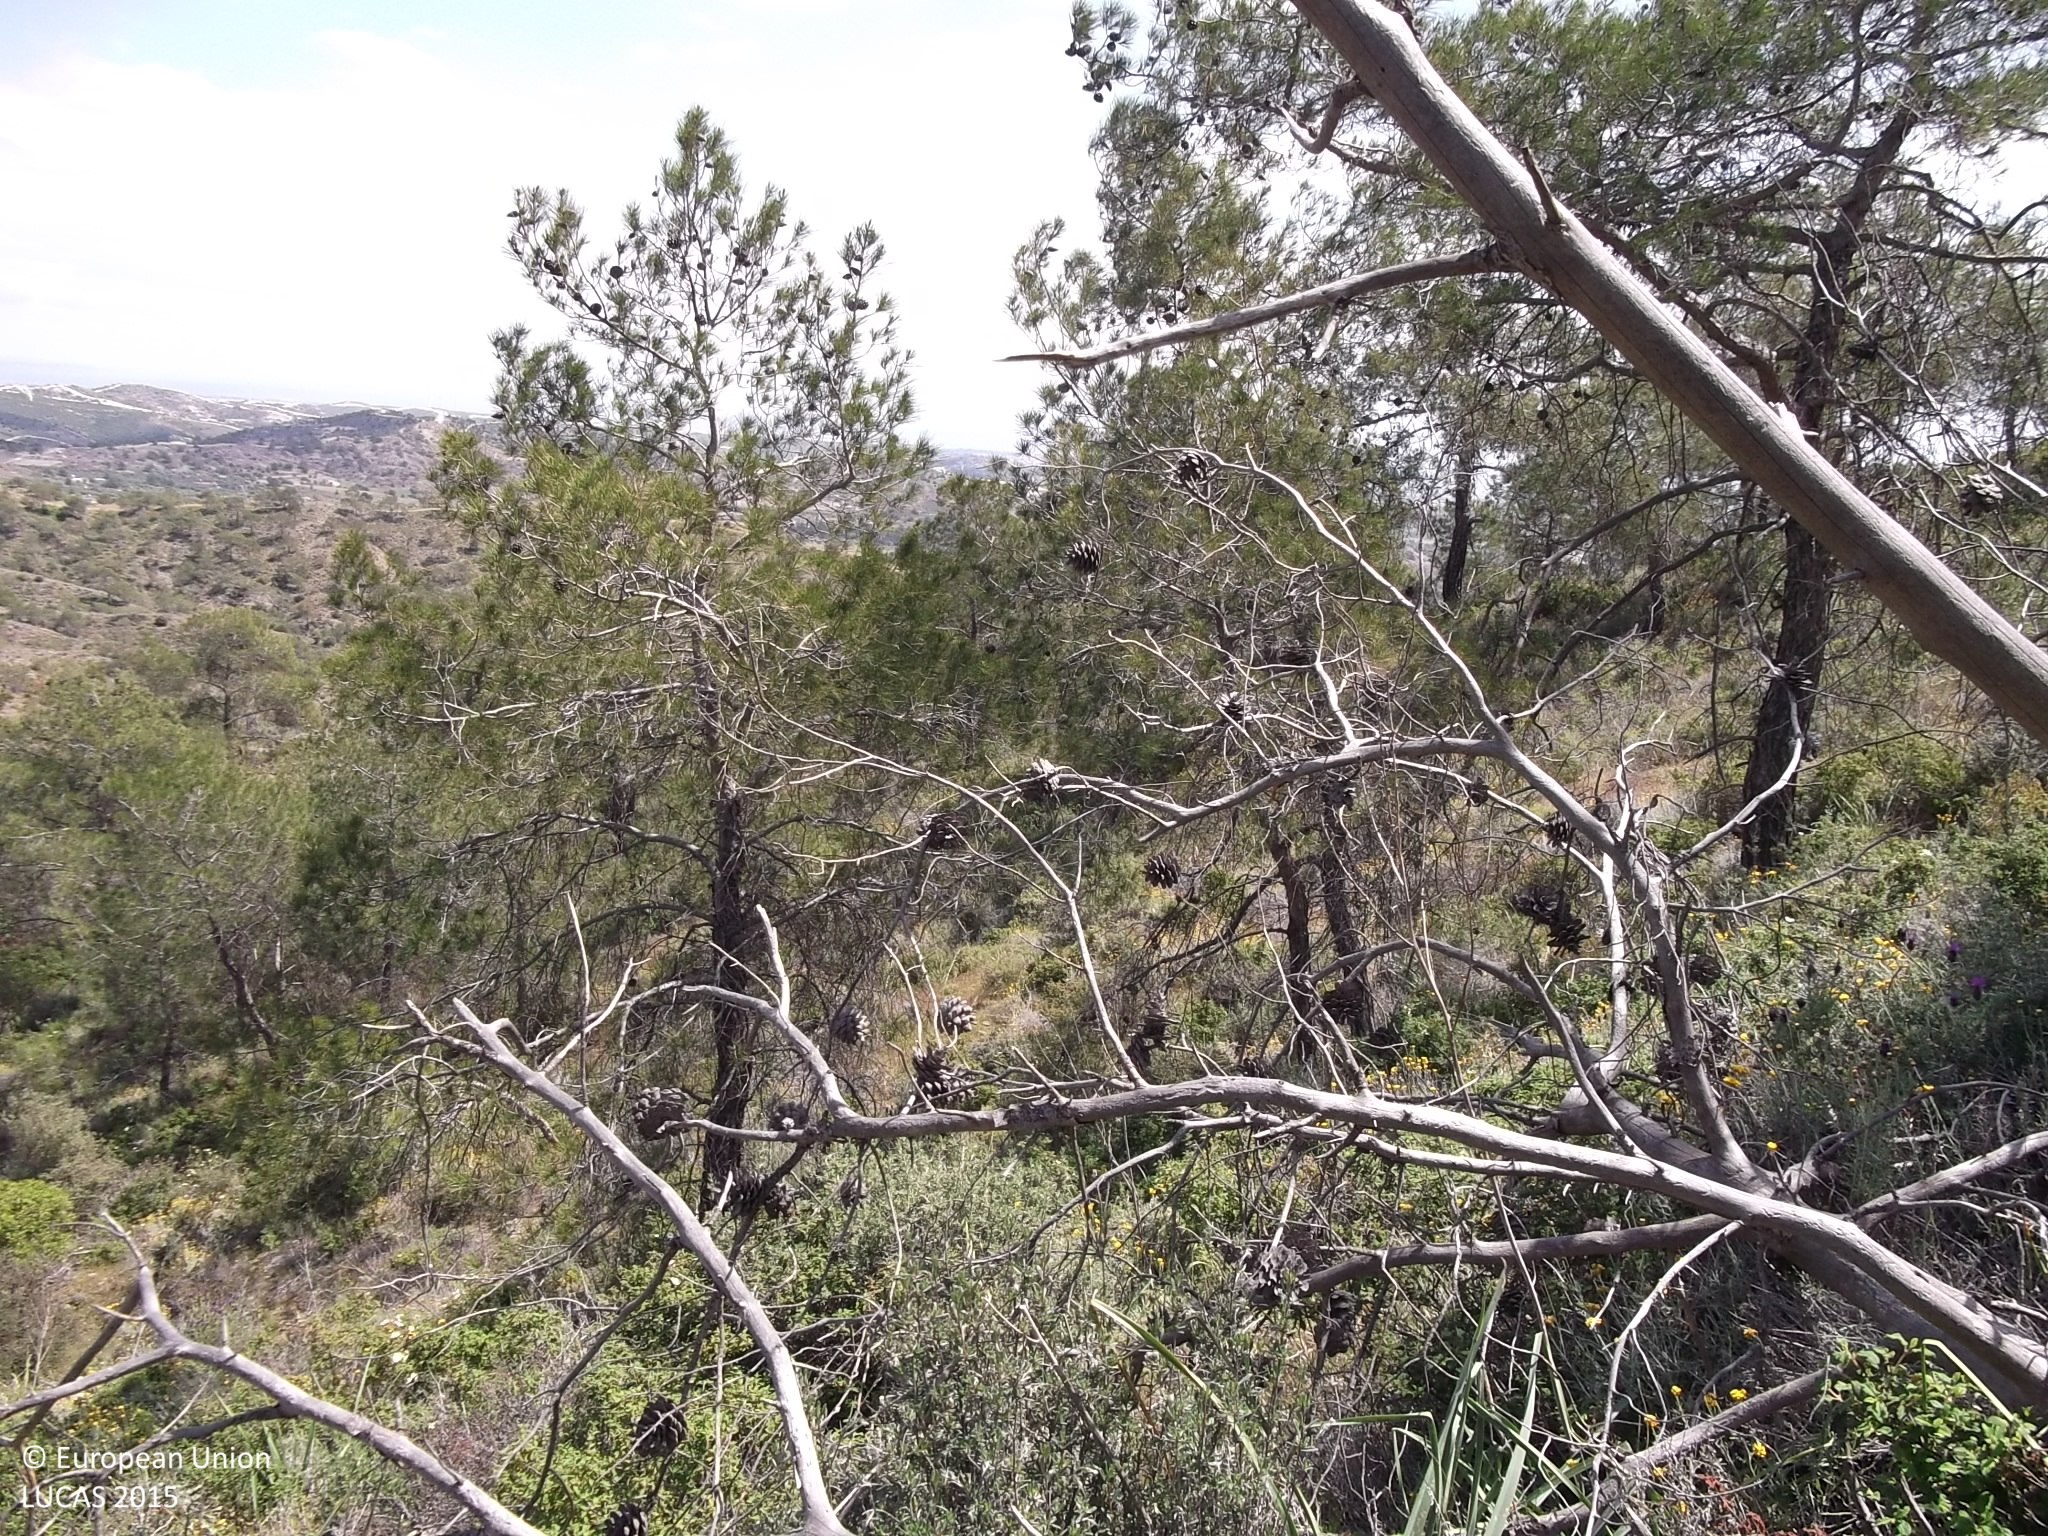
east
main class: Woodland
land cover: Pine dominated coniferous woodland
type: coniferous forest of the mediterranean region
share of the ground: > 75 %
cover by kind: coniferous forest trees 70 %, shrubs 25 %, broadleaved forest trees 5 %
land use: Semi-natural and natural areas not in use
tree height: > 5 m
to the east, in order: Pine dominated coniferous woodland; Shrubland with sparse tree cover; Pine dominated coniferous woodland; Shrubland with sparse tree cover; Rivers and streams; Shrubland with sparse tree cover
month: April
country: CY
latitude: 34.8698
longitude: 33.4331
